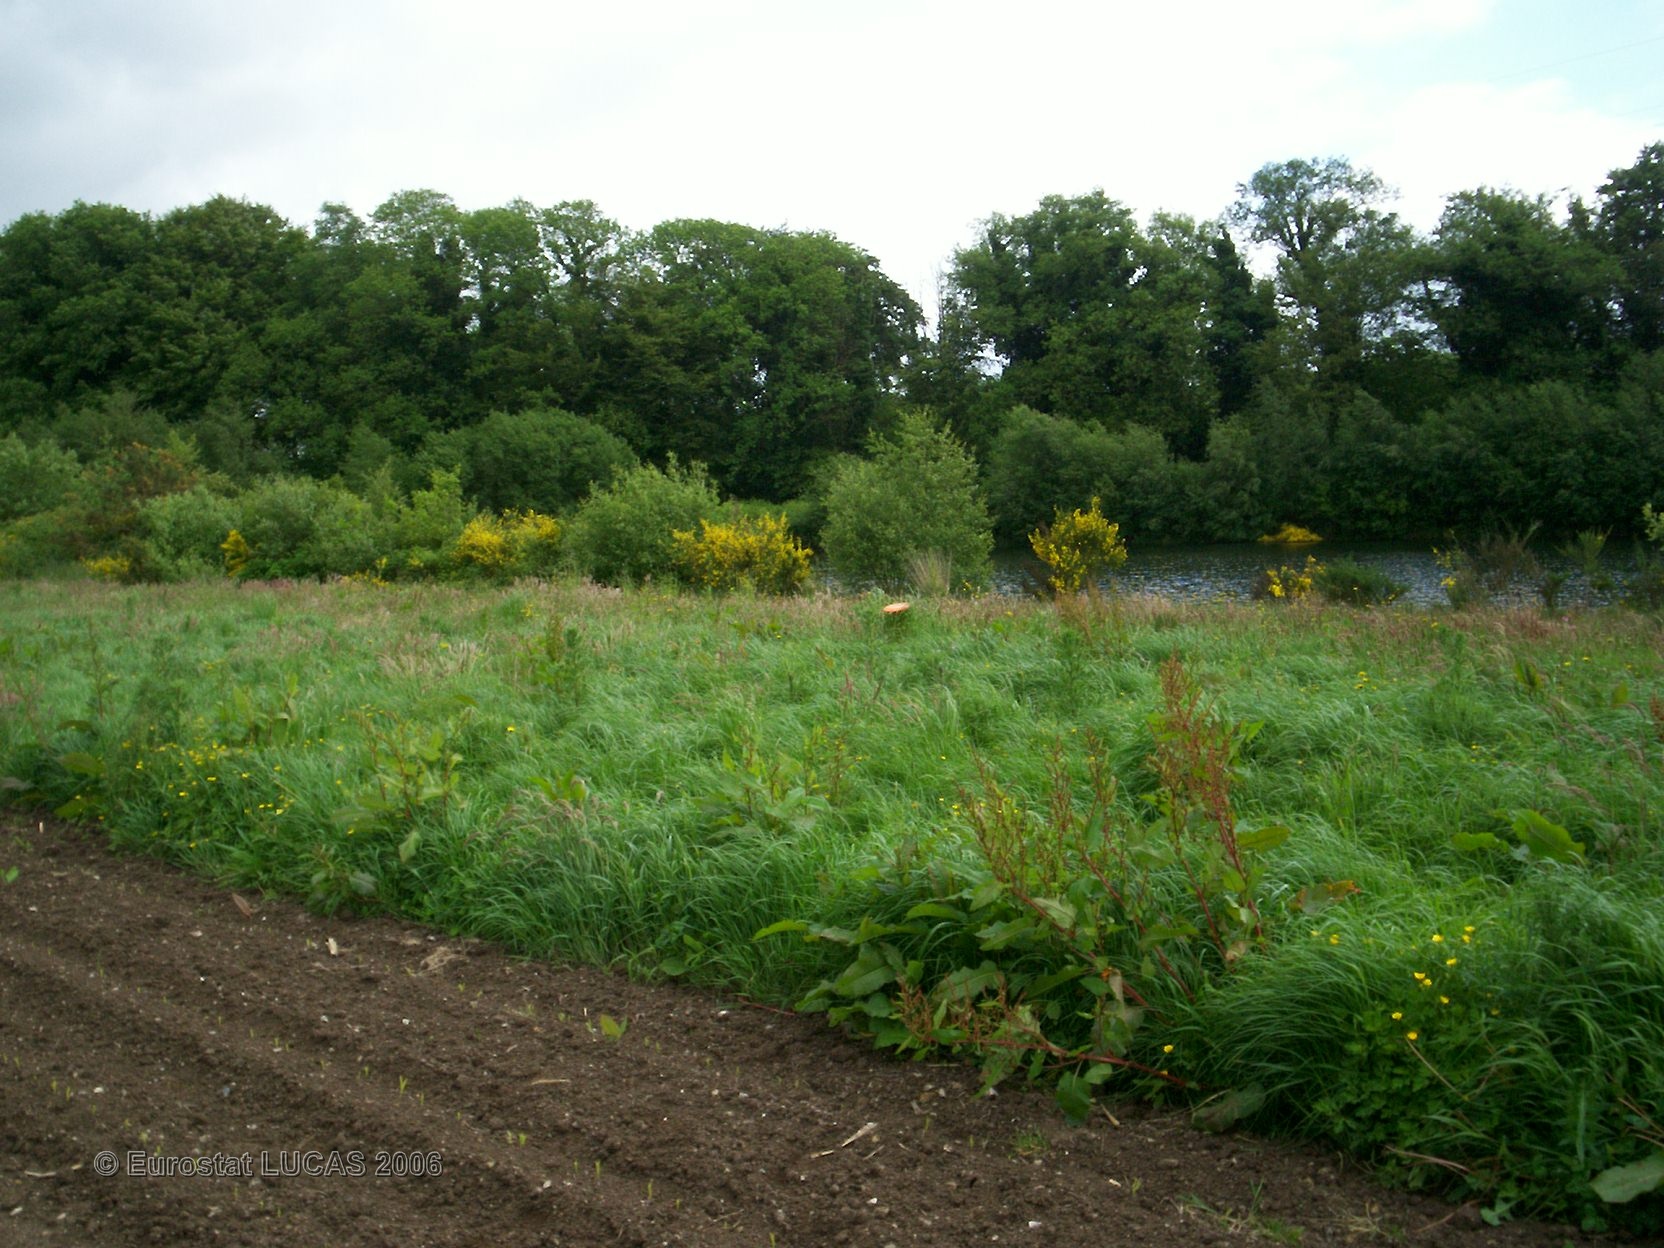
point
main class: Grassland
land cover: Grassland without tree/shrub cover
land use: Fallow land
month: May
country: FR
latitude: 47.9465
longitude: -3.5599
